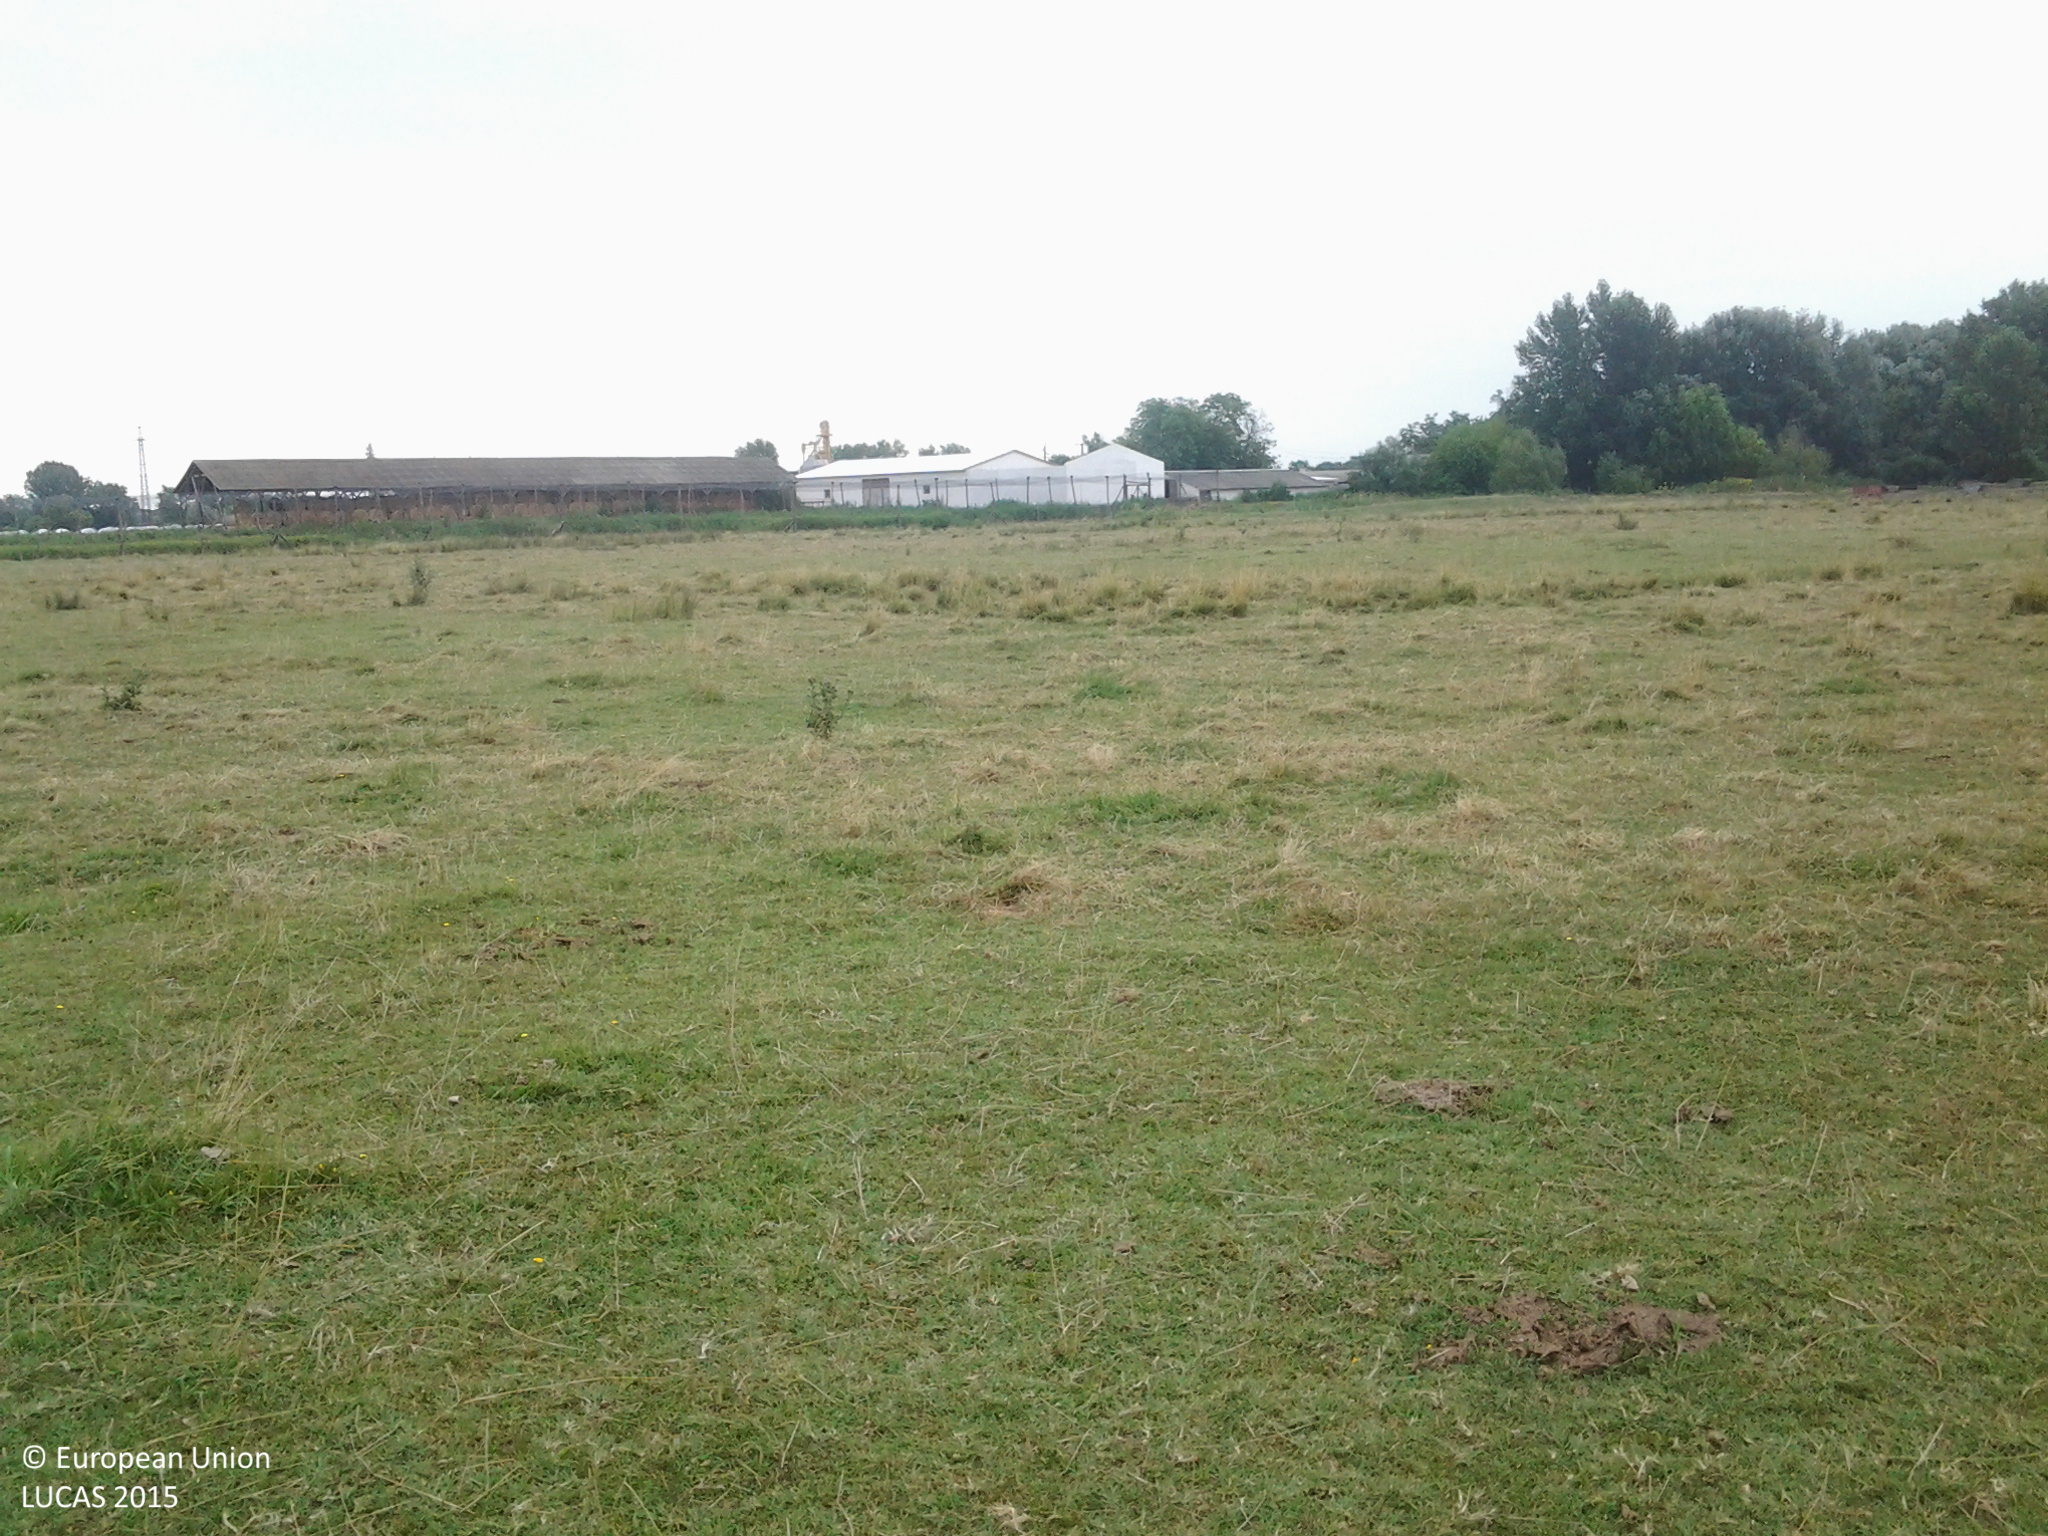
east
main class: Grassland
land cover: Grassland without tree/shrub cover
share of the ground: > 75 %
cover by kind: herbaceous plants 100 %
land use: Agriculture (excluding fallow land and kitchen gardens)
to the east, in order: Grassland without tree/shrub cover; Other fresh vegetables; Artificial constructions in urban areas
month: July
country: HU
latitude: 46.6381
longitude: 19.2518
